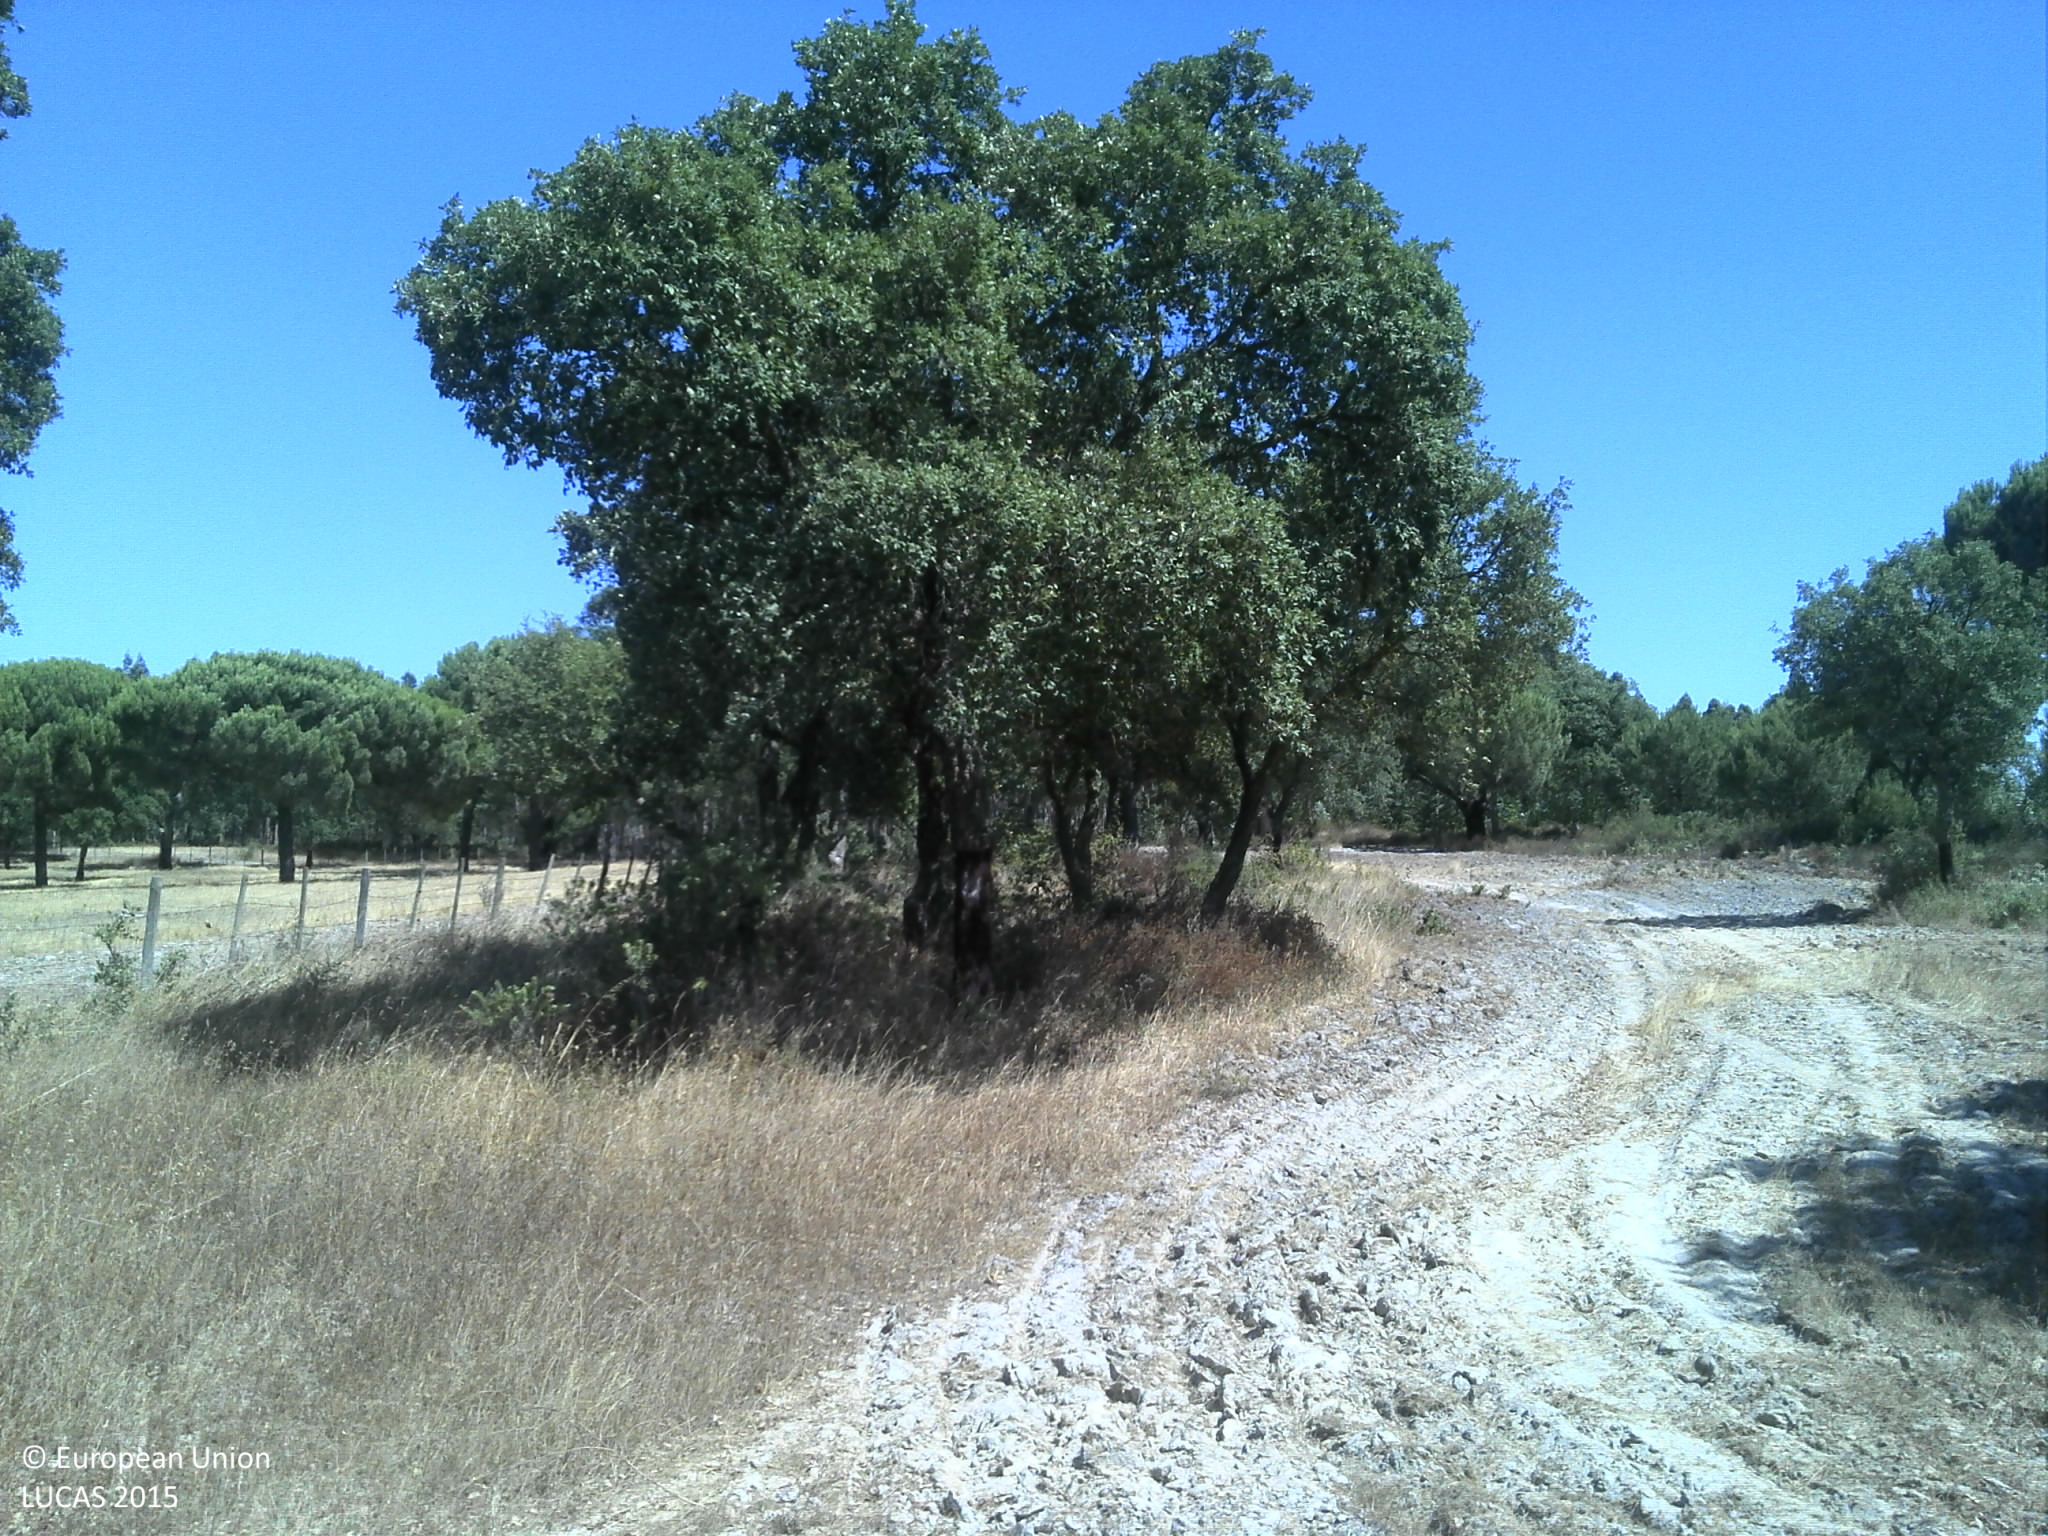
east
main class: Cropland
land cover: Temporary grasslands
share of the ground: 25 - 50 %
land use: Agriculture (excluding fallow land and kitchen gardens)
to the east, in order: Temporary grasslands; Fences; Other structural elements; Grassland without tree/shrub cover; Fences; Broadleaved woodland
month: July
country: PT
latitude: 38.8368
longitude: -8.6222
